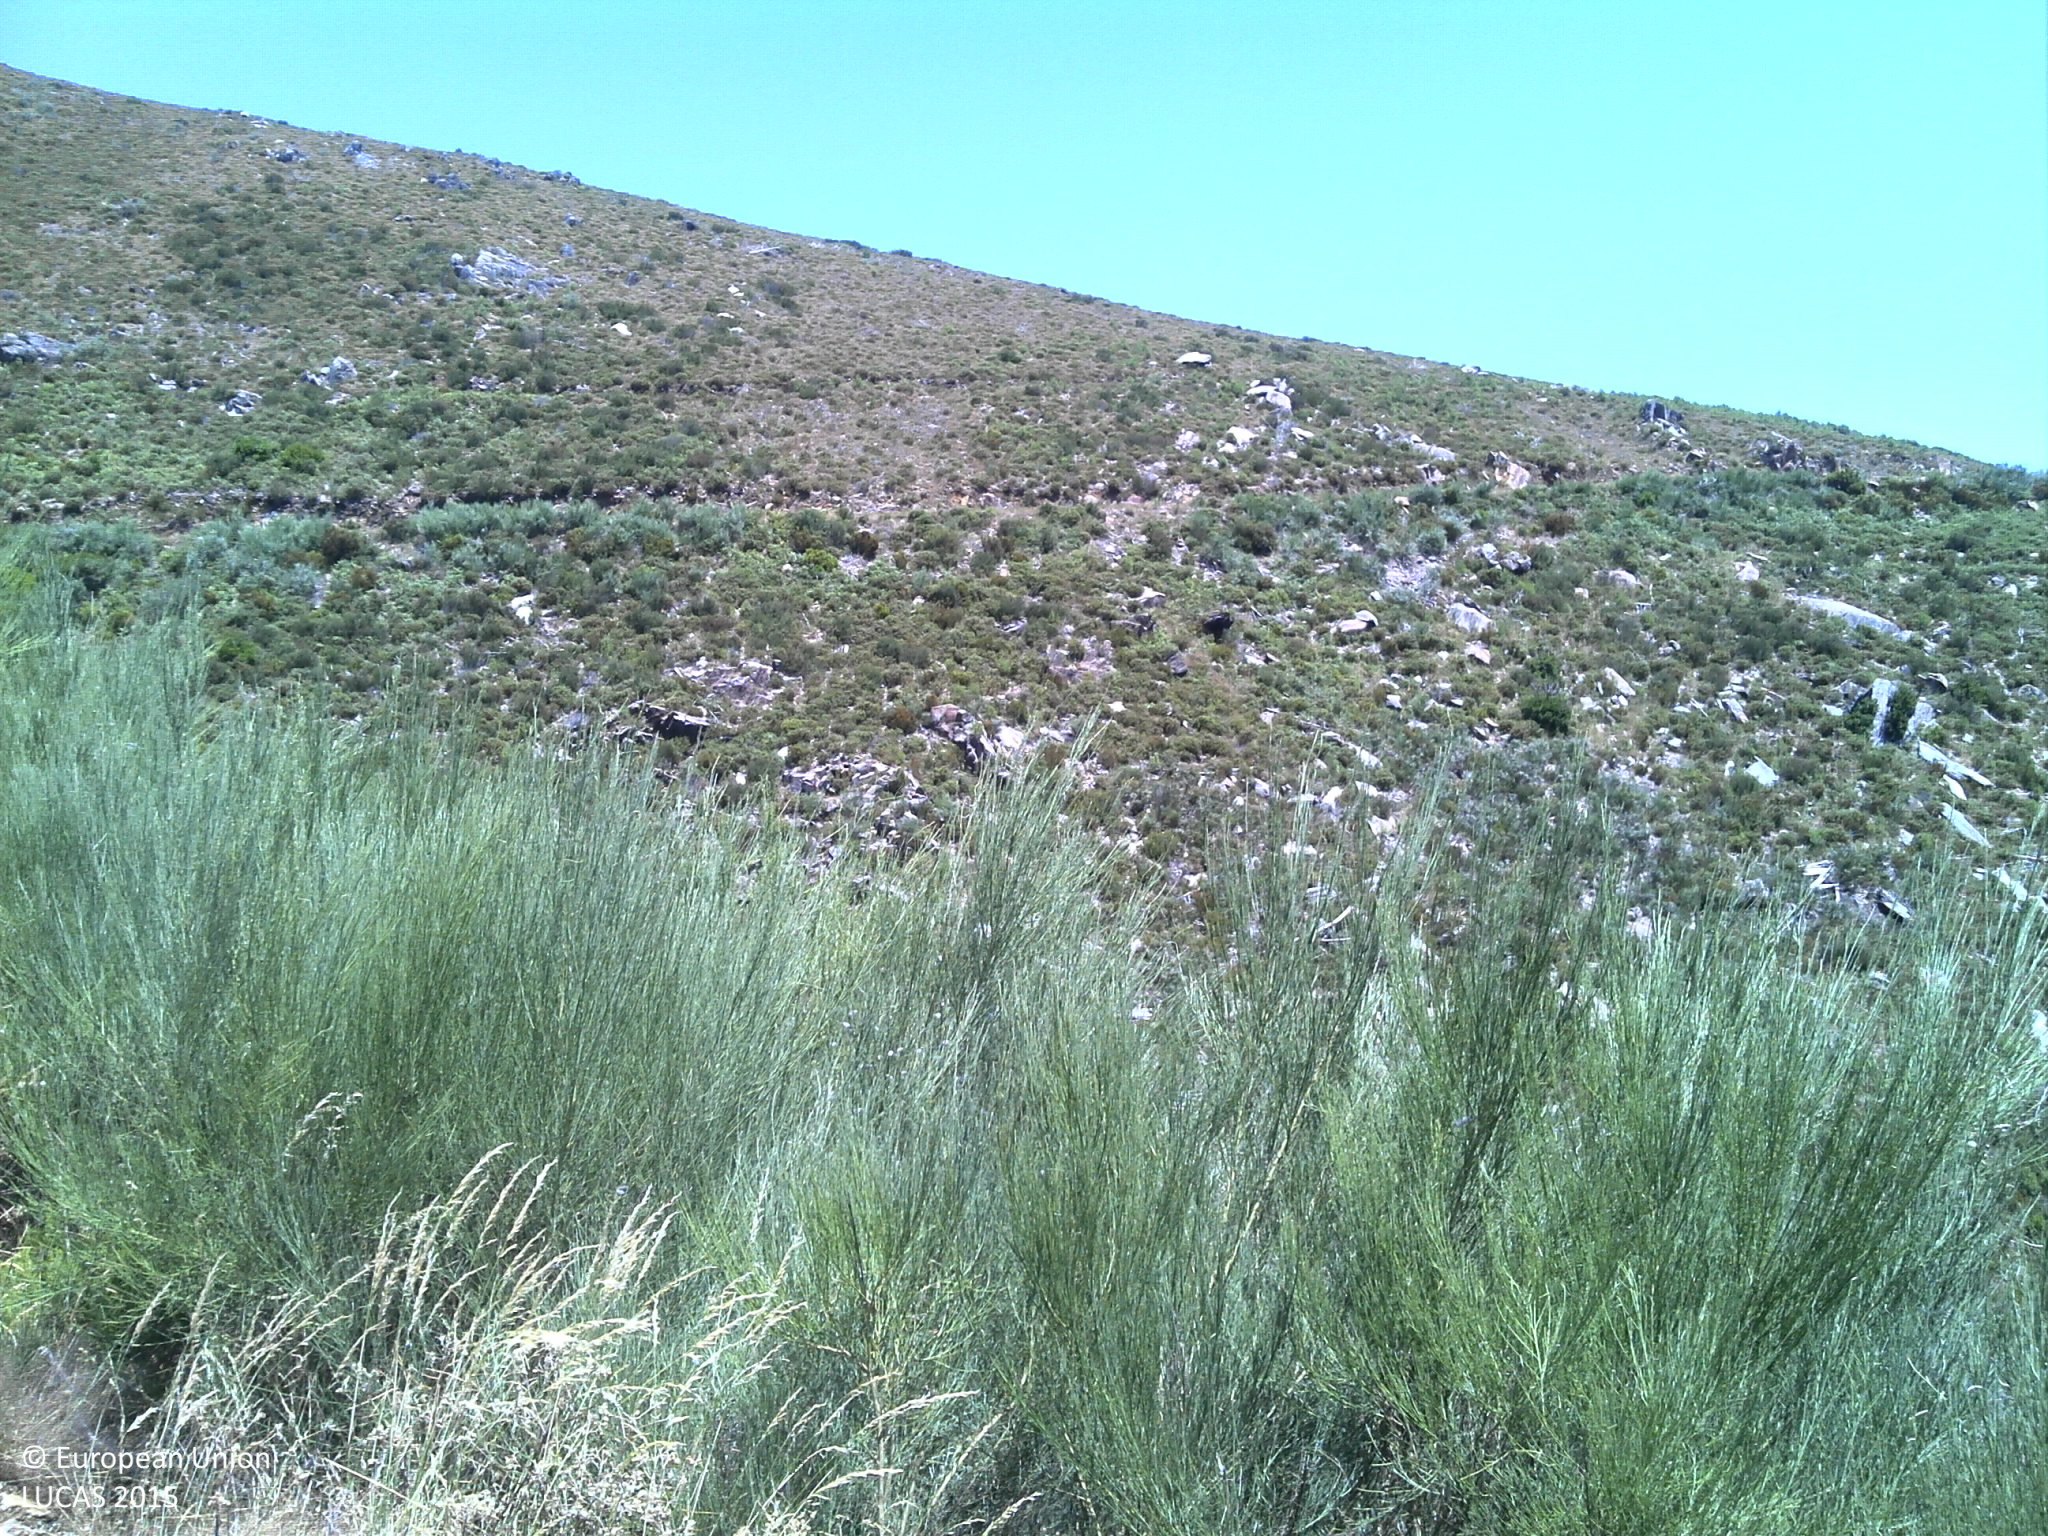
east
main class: Shrubland
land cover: Shrubland without tree cover
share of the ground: > 75 %
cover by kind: shrubs 85 %, unconsolidated bare surface 15 %
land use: Semi-natural and natural areas not in use
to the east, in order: Shrubland without tree cover; Paved roads, cycling and walking lanes; Shrubland without tree cover; Rock outcrops; Rivers and streams; Shrubland without tree cover; Grass margins; Paved roads, cycling and walking lanes; Shrubland without tree cover
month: June
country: PT
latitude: 40.8233
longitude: -8.0954
